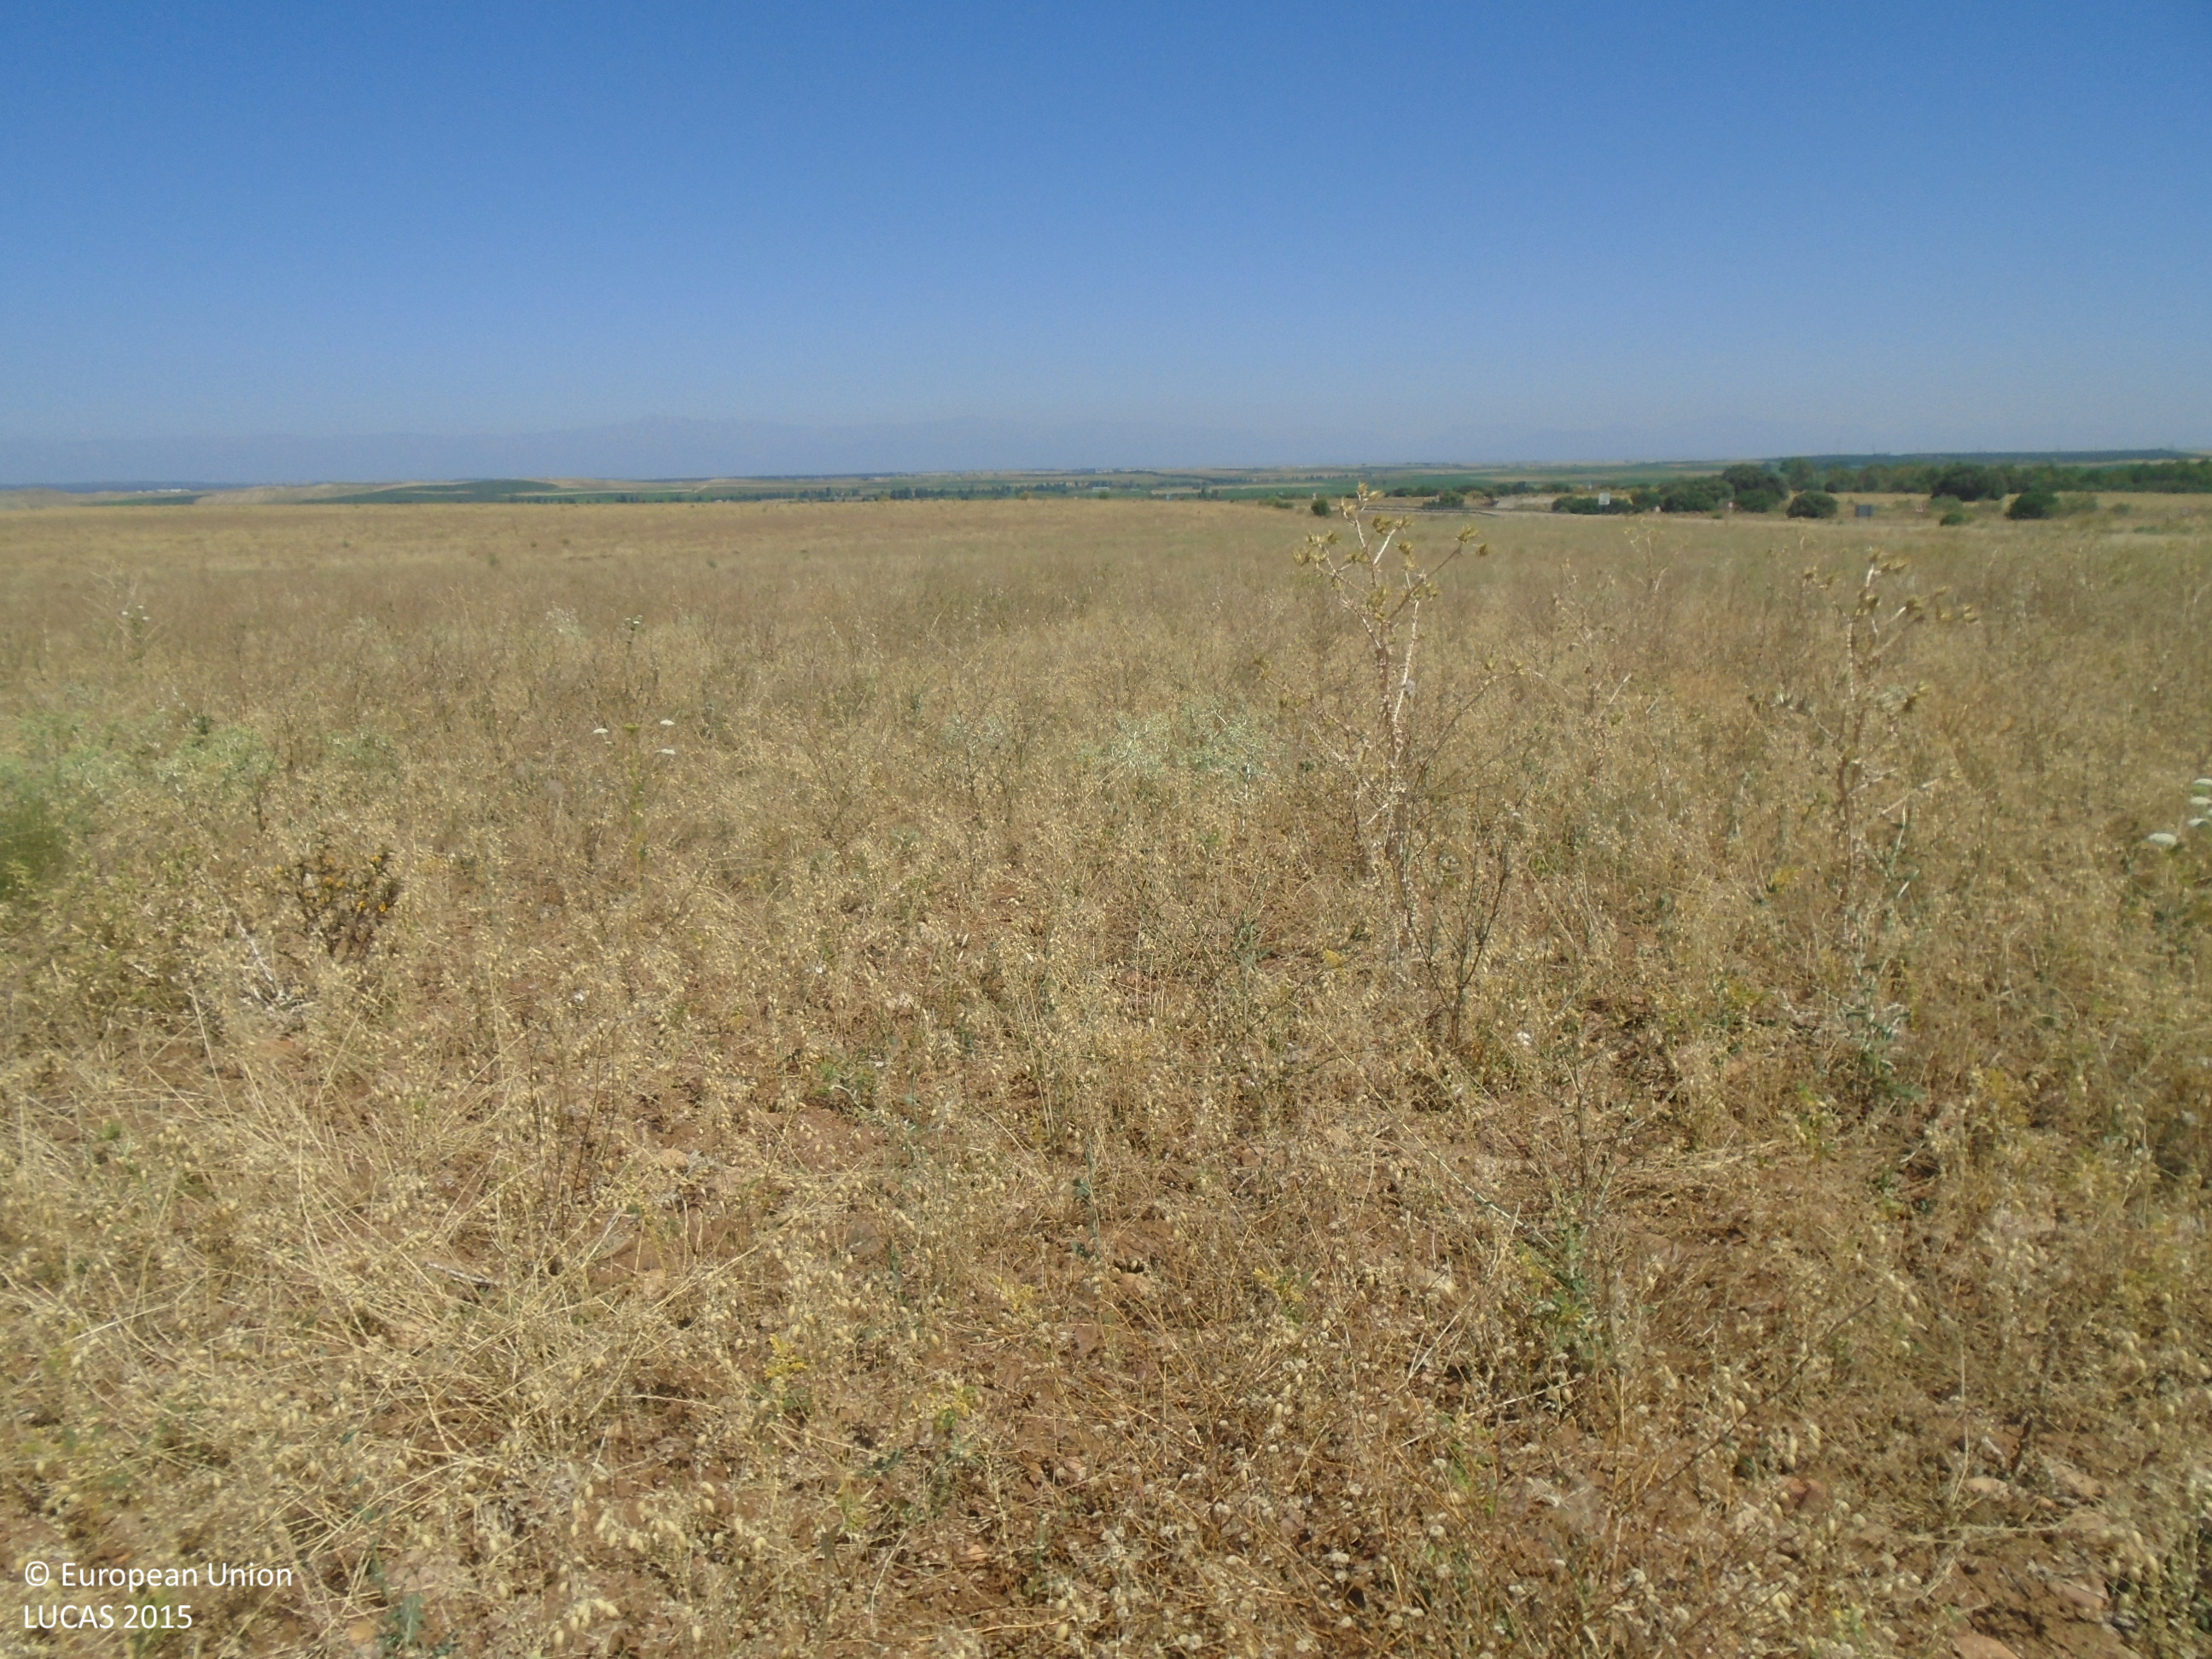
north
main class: Grassland
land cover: Spontaneously vegetated surfaces
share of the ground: > 75 %
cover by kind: herbaceous plants 100 %
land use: Fallow land
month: July
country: ES
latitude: 39.7711
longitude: -5.0976
